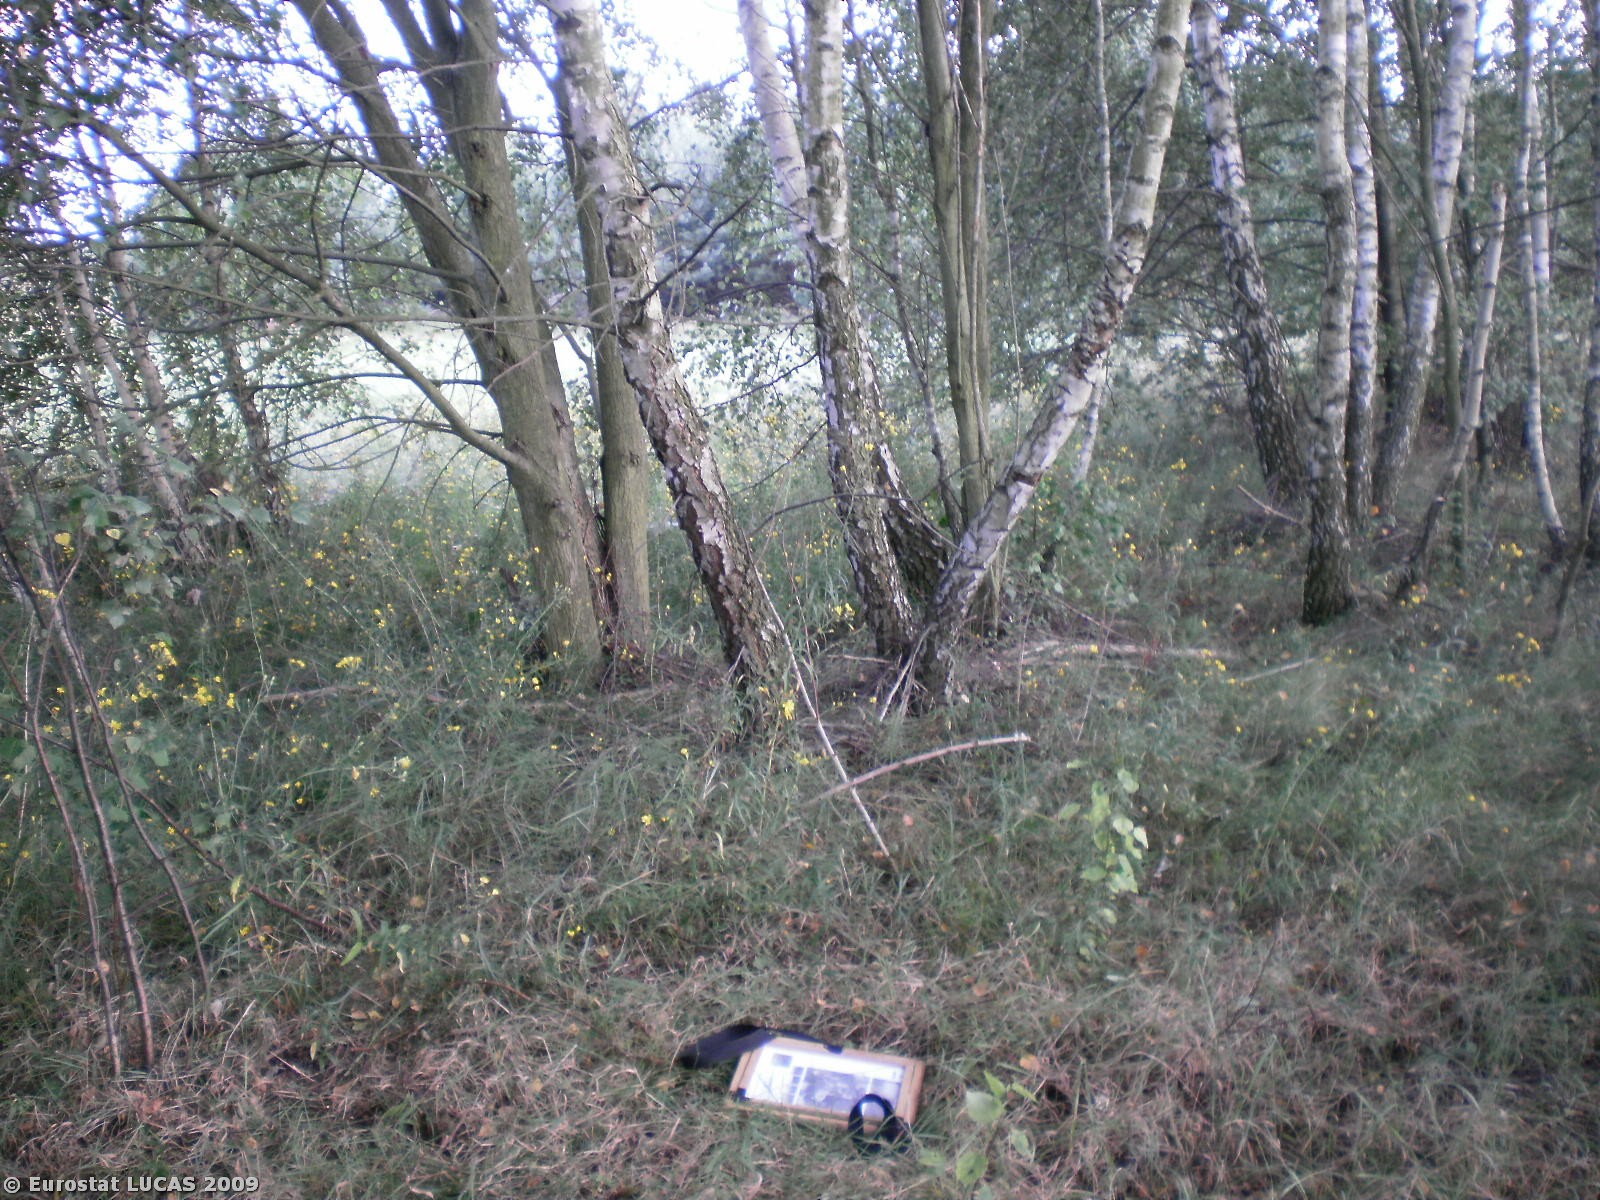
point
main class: Woodland
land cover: Broadleaved woodland
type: mesophytic deciduous forest
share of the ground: > 75 %
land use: Unused
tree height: > 5 m
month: August
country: PL
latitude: 53.0562
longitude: 21.8272
